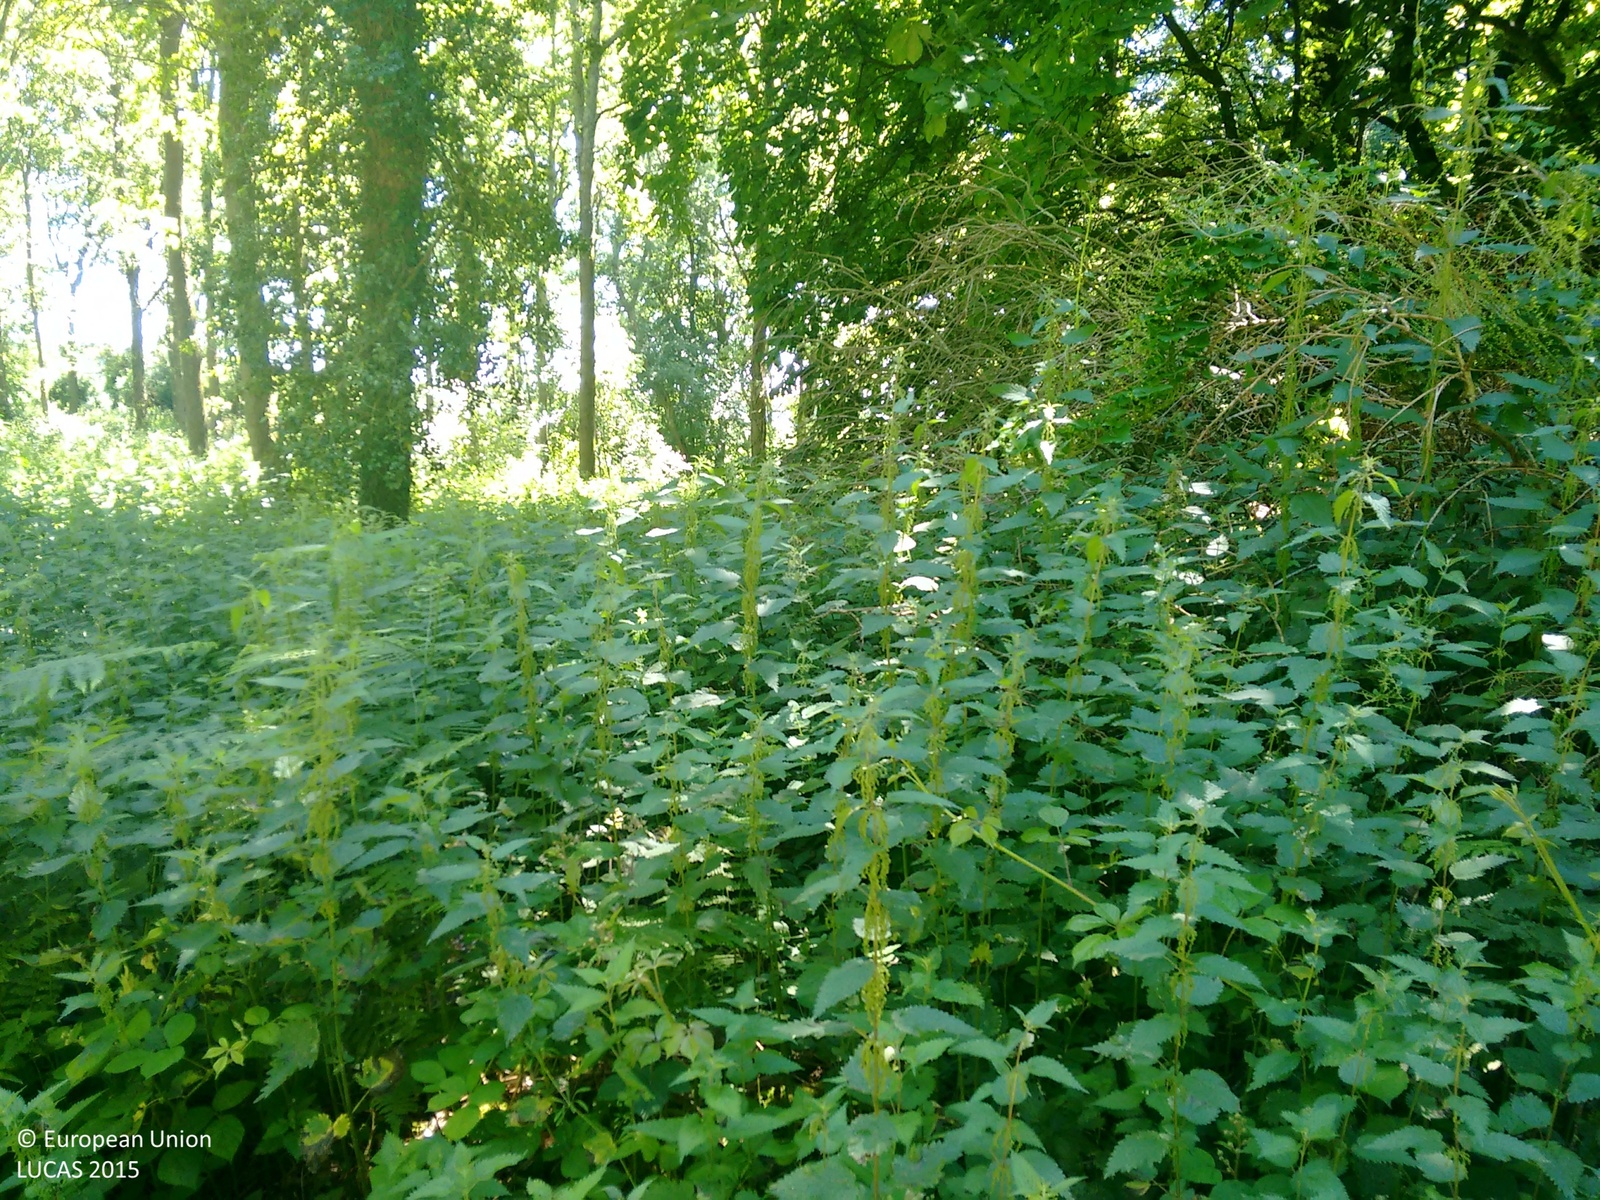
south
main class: Woodland
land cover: Broadleaved woodland
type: mesophytic deciduous forest
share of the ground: > 75 %
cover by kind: broadleaved forest trees 100 %
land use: Forestry
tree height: > 5 m
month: June
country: GB
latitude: 50.8605
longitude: -0.4802
